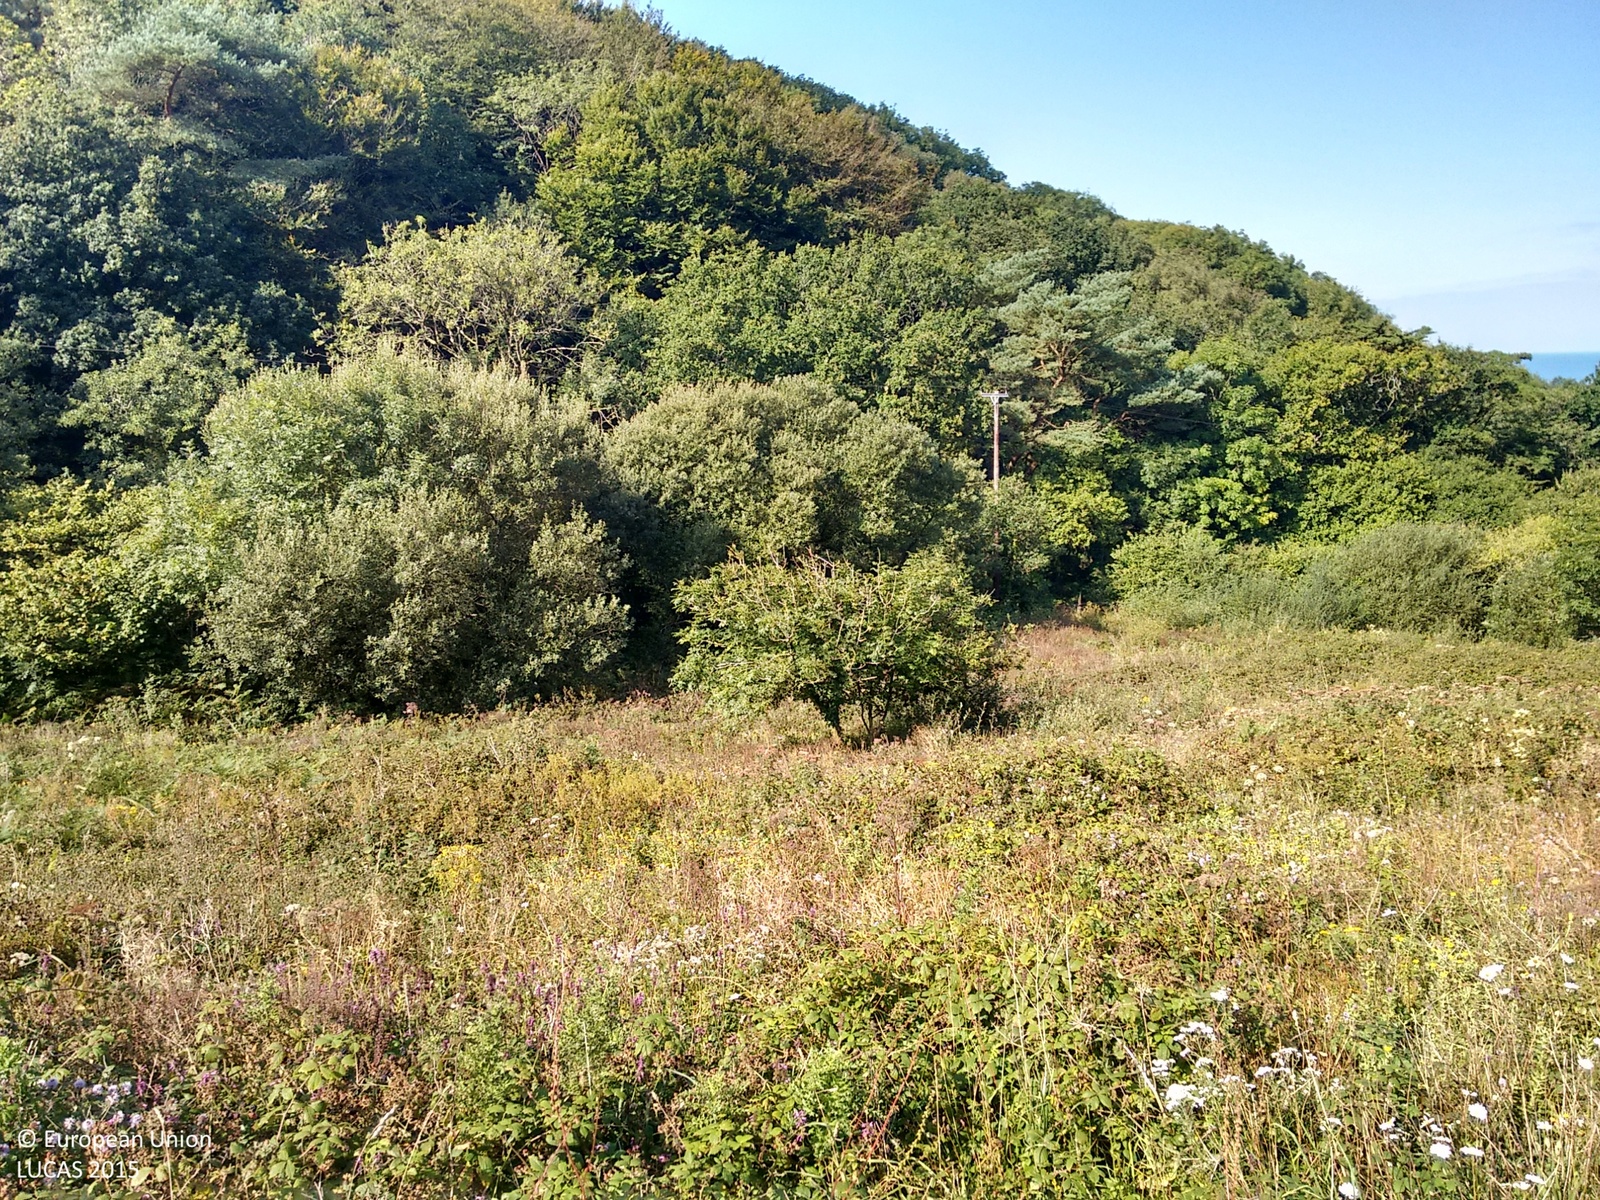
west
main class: Grassland
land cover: Grassland without tree/shrub cover
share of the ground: > 75 %
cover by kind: herbaceous plants 100 %
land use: Agriculture (excluding fallow land and kitchen gardens)
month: September
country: GB
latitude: 50.9933
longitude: -4.3056
